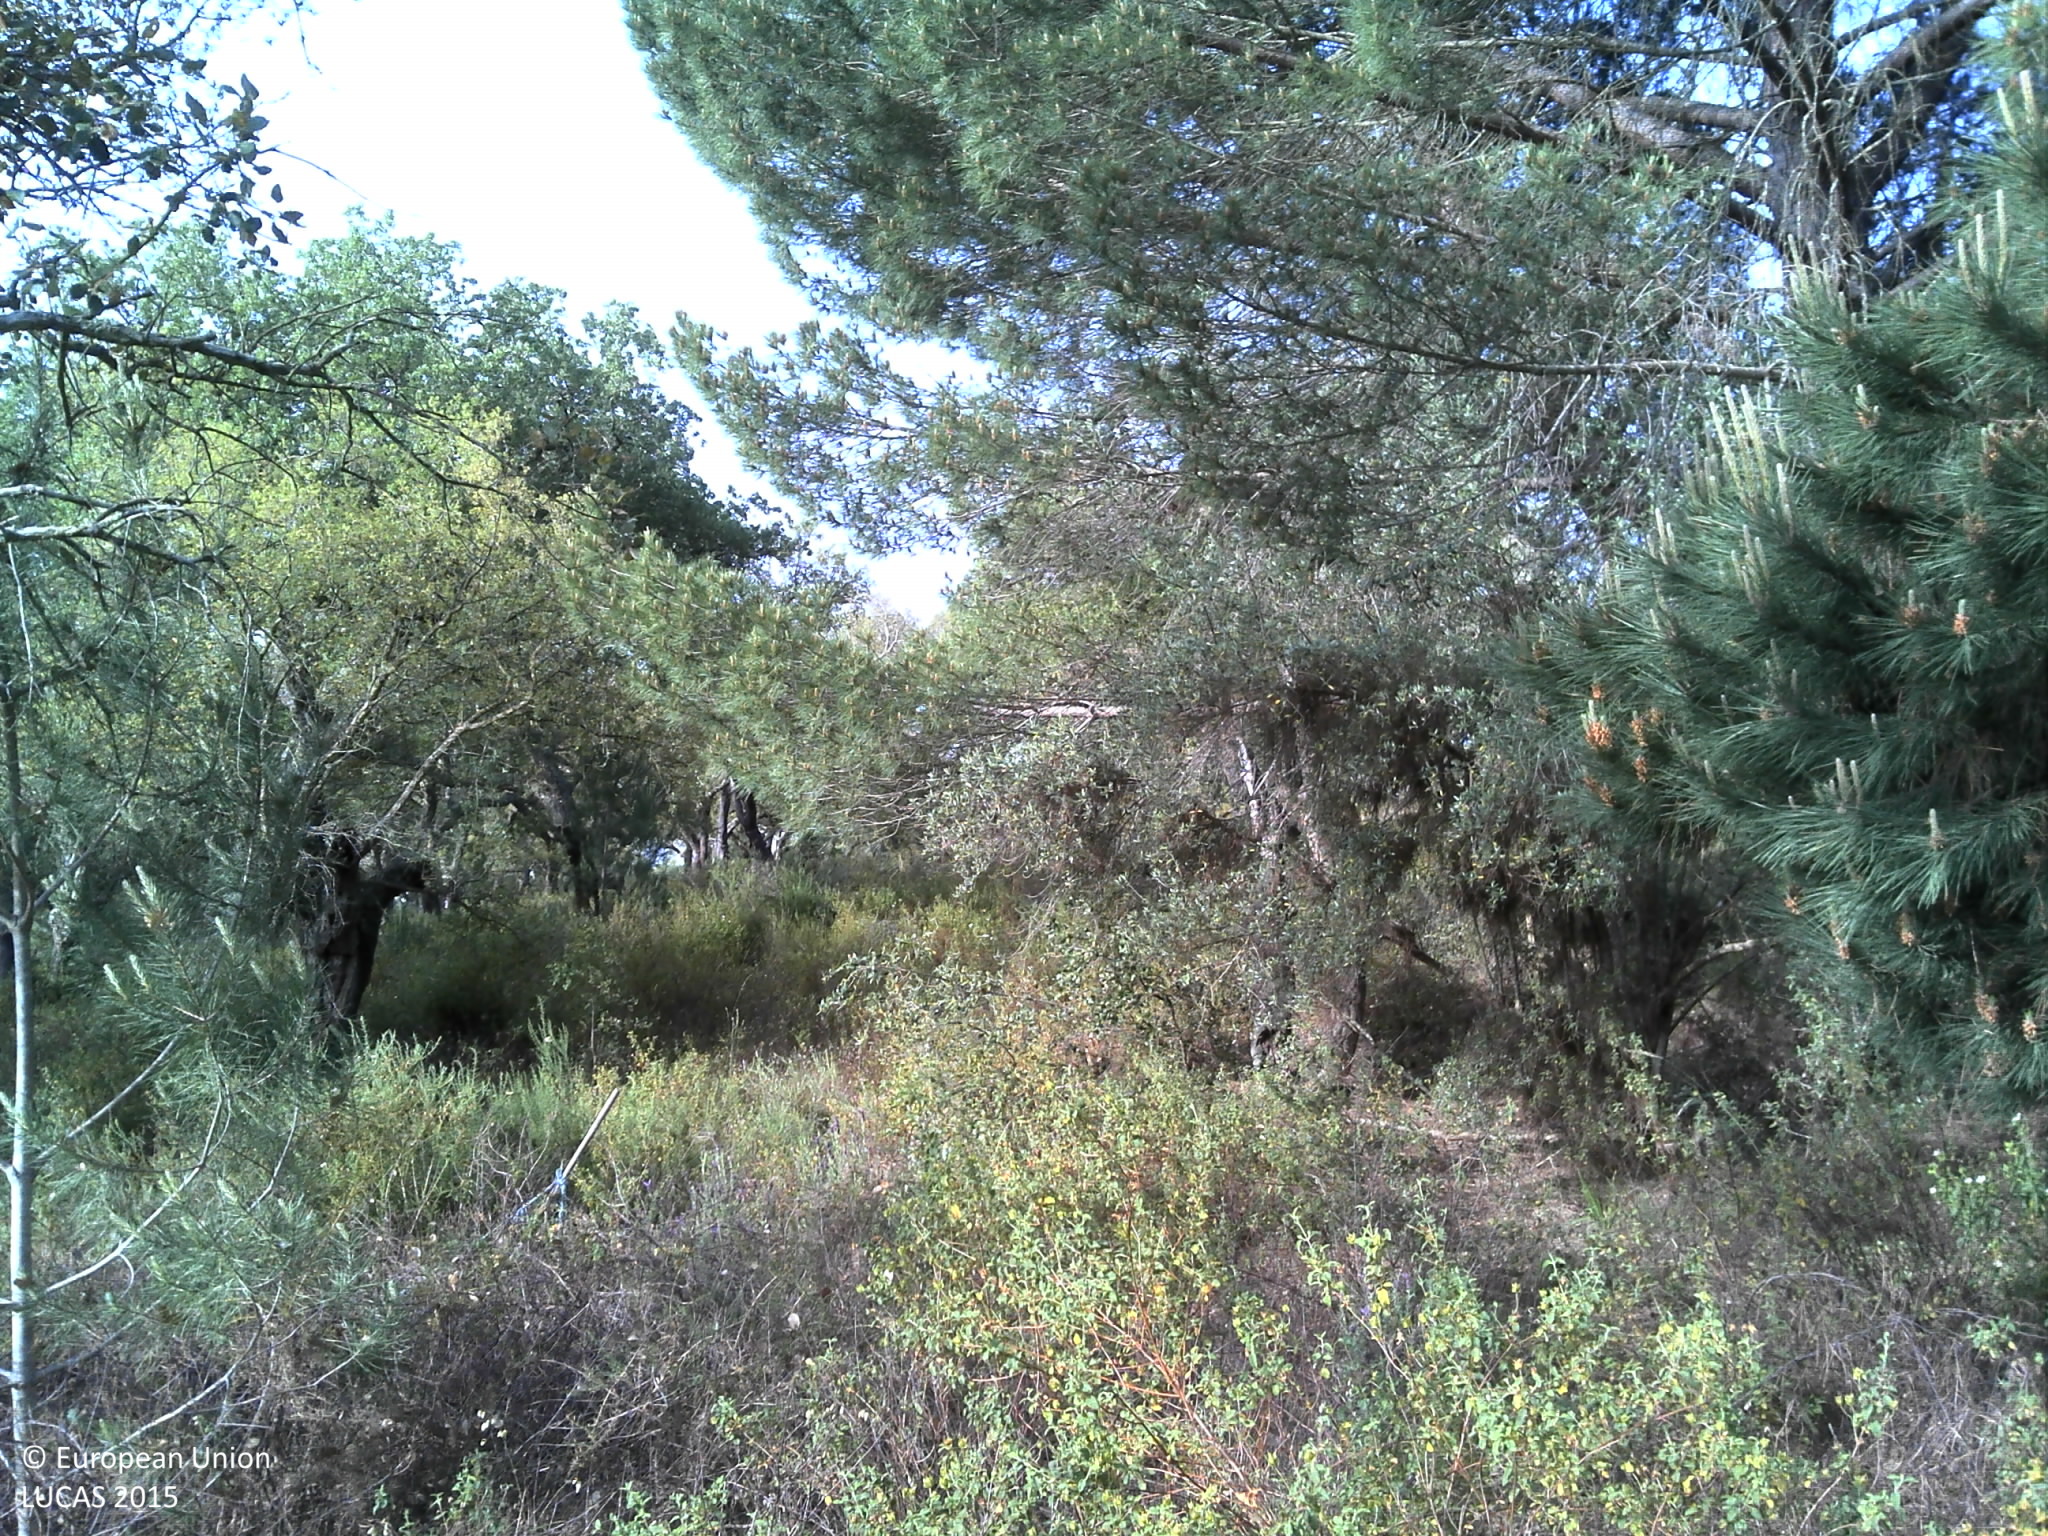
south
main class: Woodland
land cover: Broadleaved woodland
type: broadleaved evergreen forest
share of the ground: 10 - 25 %
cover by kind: shrubs 30 %, herbaceous plants 30 %, broadleaved forest trees 25 %, unconsolidated bare surface 10 %, coniferous forest trees 5 %
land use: Forestry
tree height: > 5 m
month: May
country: PT
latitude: 38.3151
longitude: -8.4505
